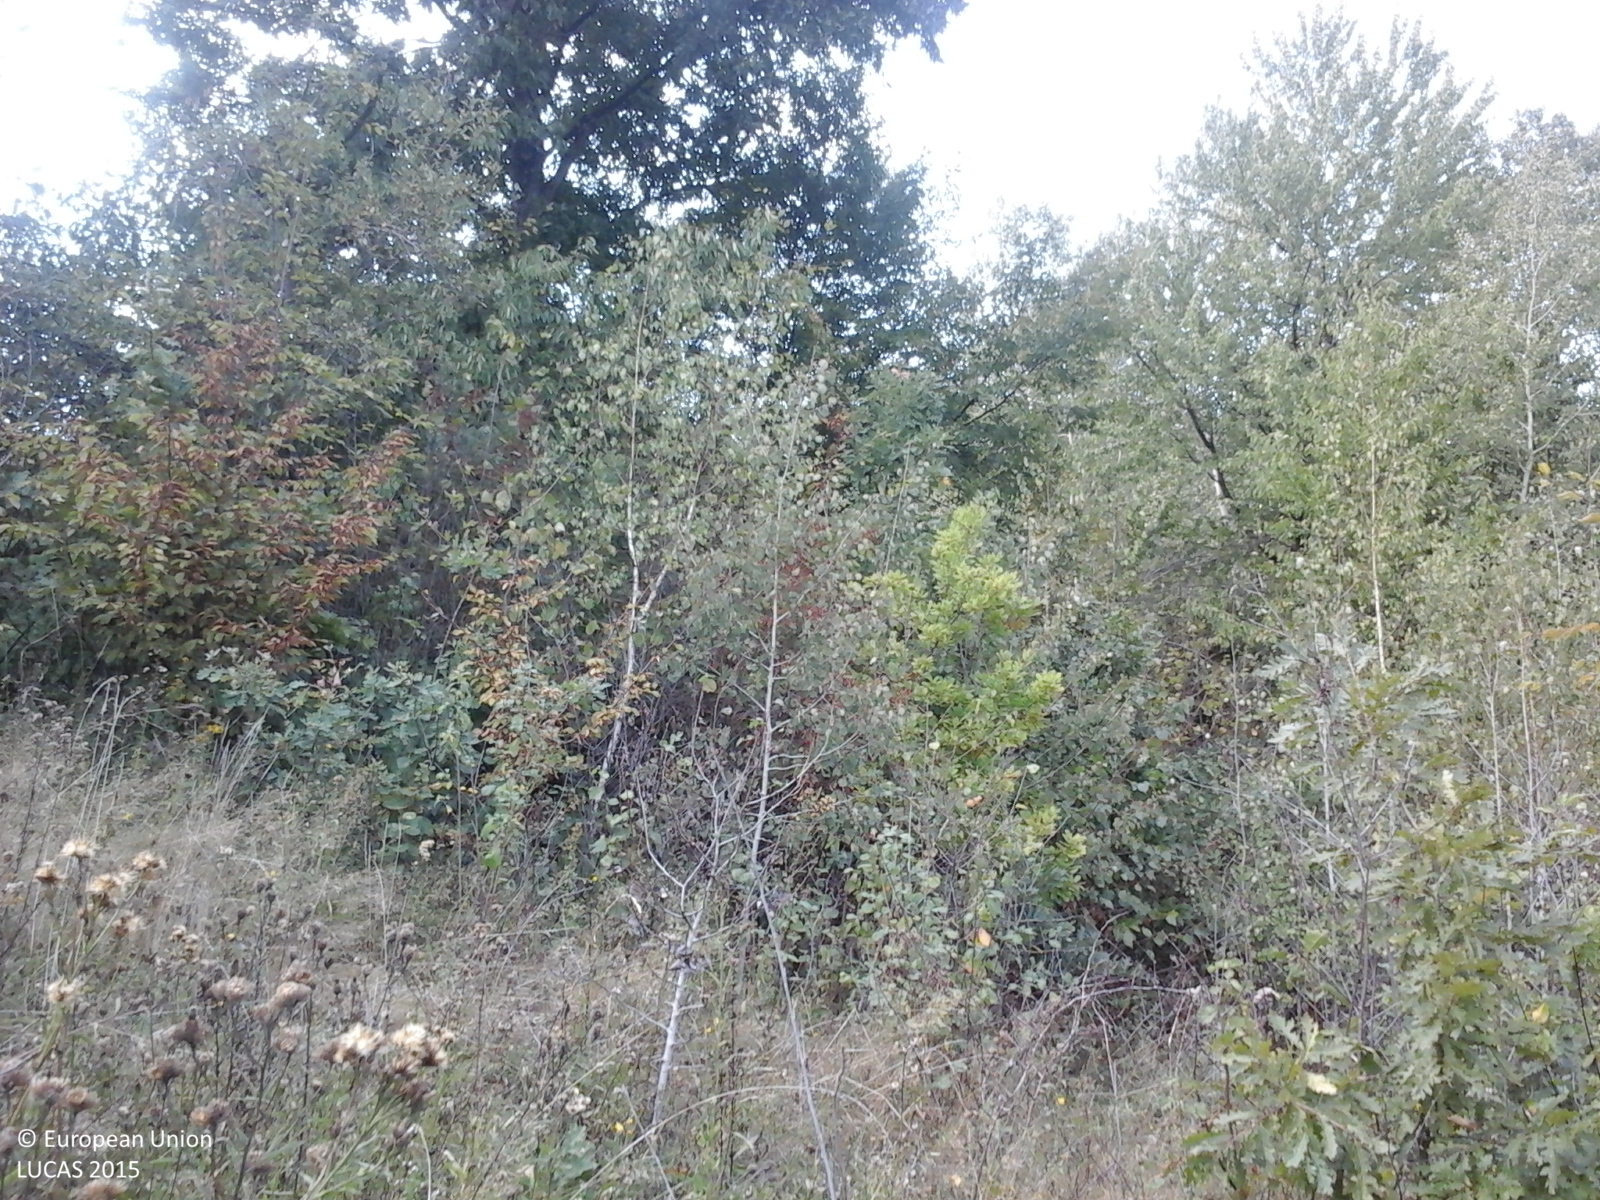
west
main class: Grassland
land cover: Grassland with sparse tree/shrub cover
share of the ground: > 75 %
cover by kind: herbaceous plants 85 %, shrubs 10 %, broadleaved forest trees 5 %
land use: Fallow land
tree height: < 5 m
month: September
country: RO
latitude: 45.3342
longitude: 22.2524
